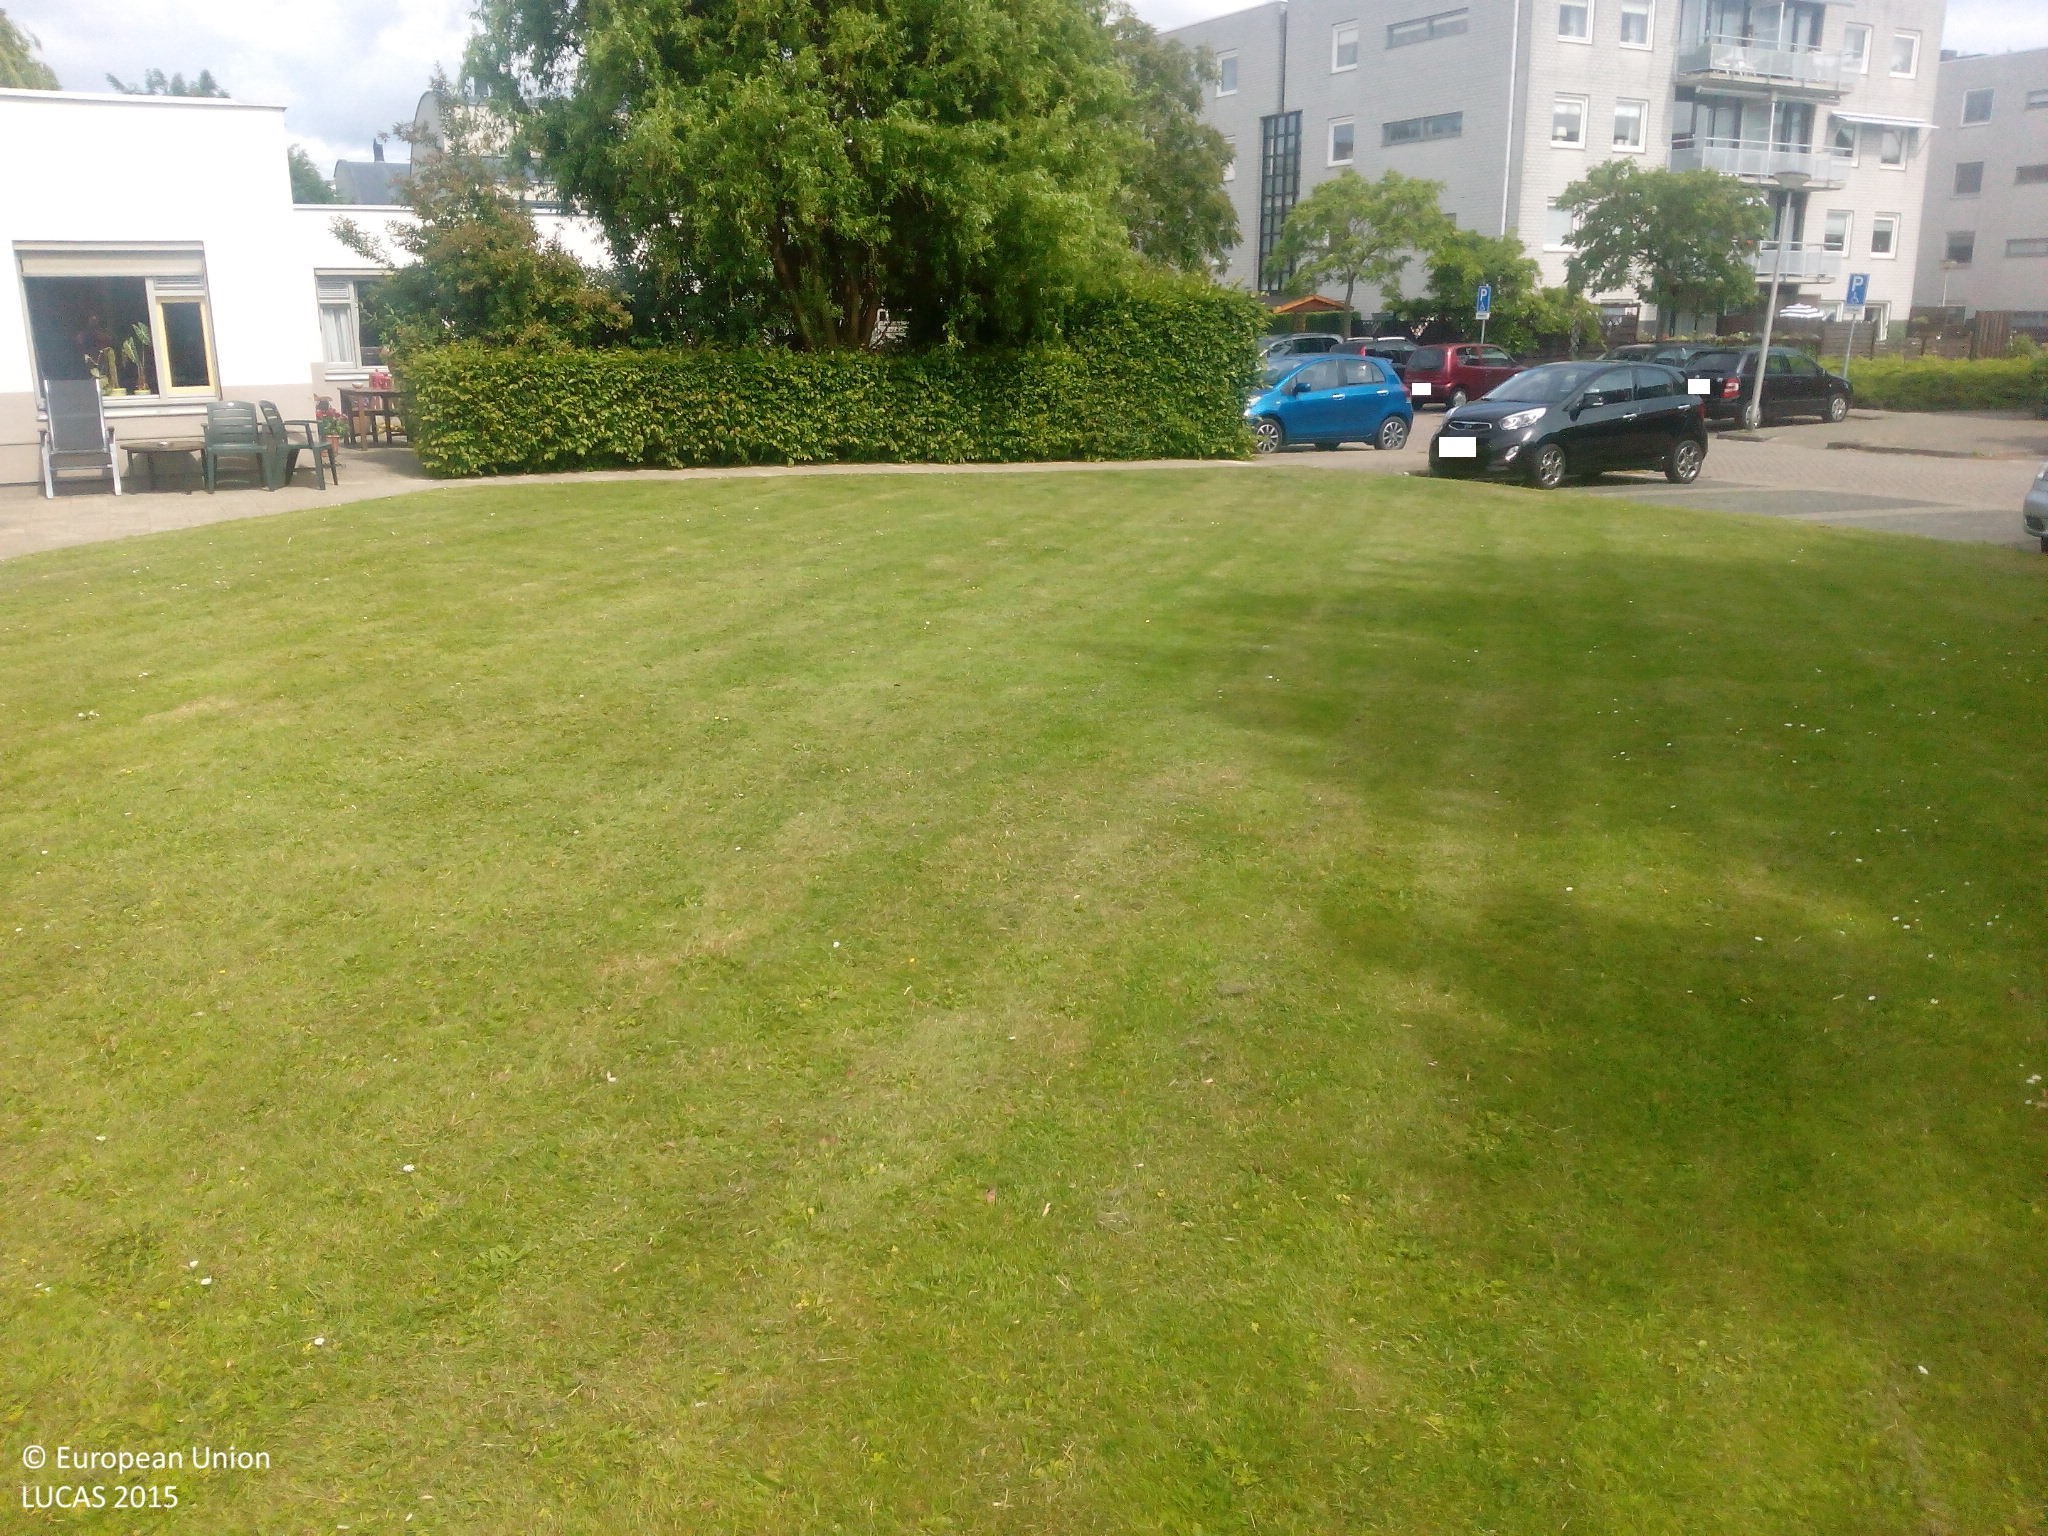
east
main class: Woodland
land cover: Broadleaved woodland
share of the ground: 25 - 50 %
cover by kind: herbaceous plants 55 %, broadleaved forest trees 30 %, consolidated bare surface 15 %
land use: Residential
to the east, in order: Broadleaved woodland; Artificial constructions in urban areas
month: June
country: NL
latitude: 51.8366
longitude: 4.1460
